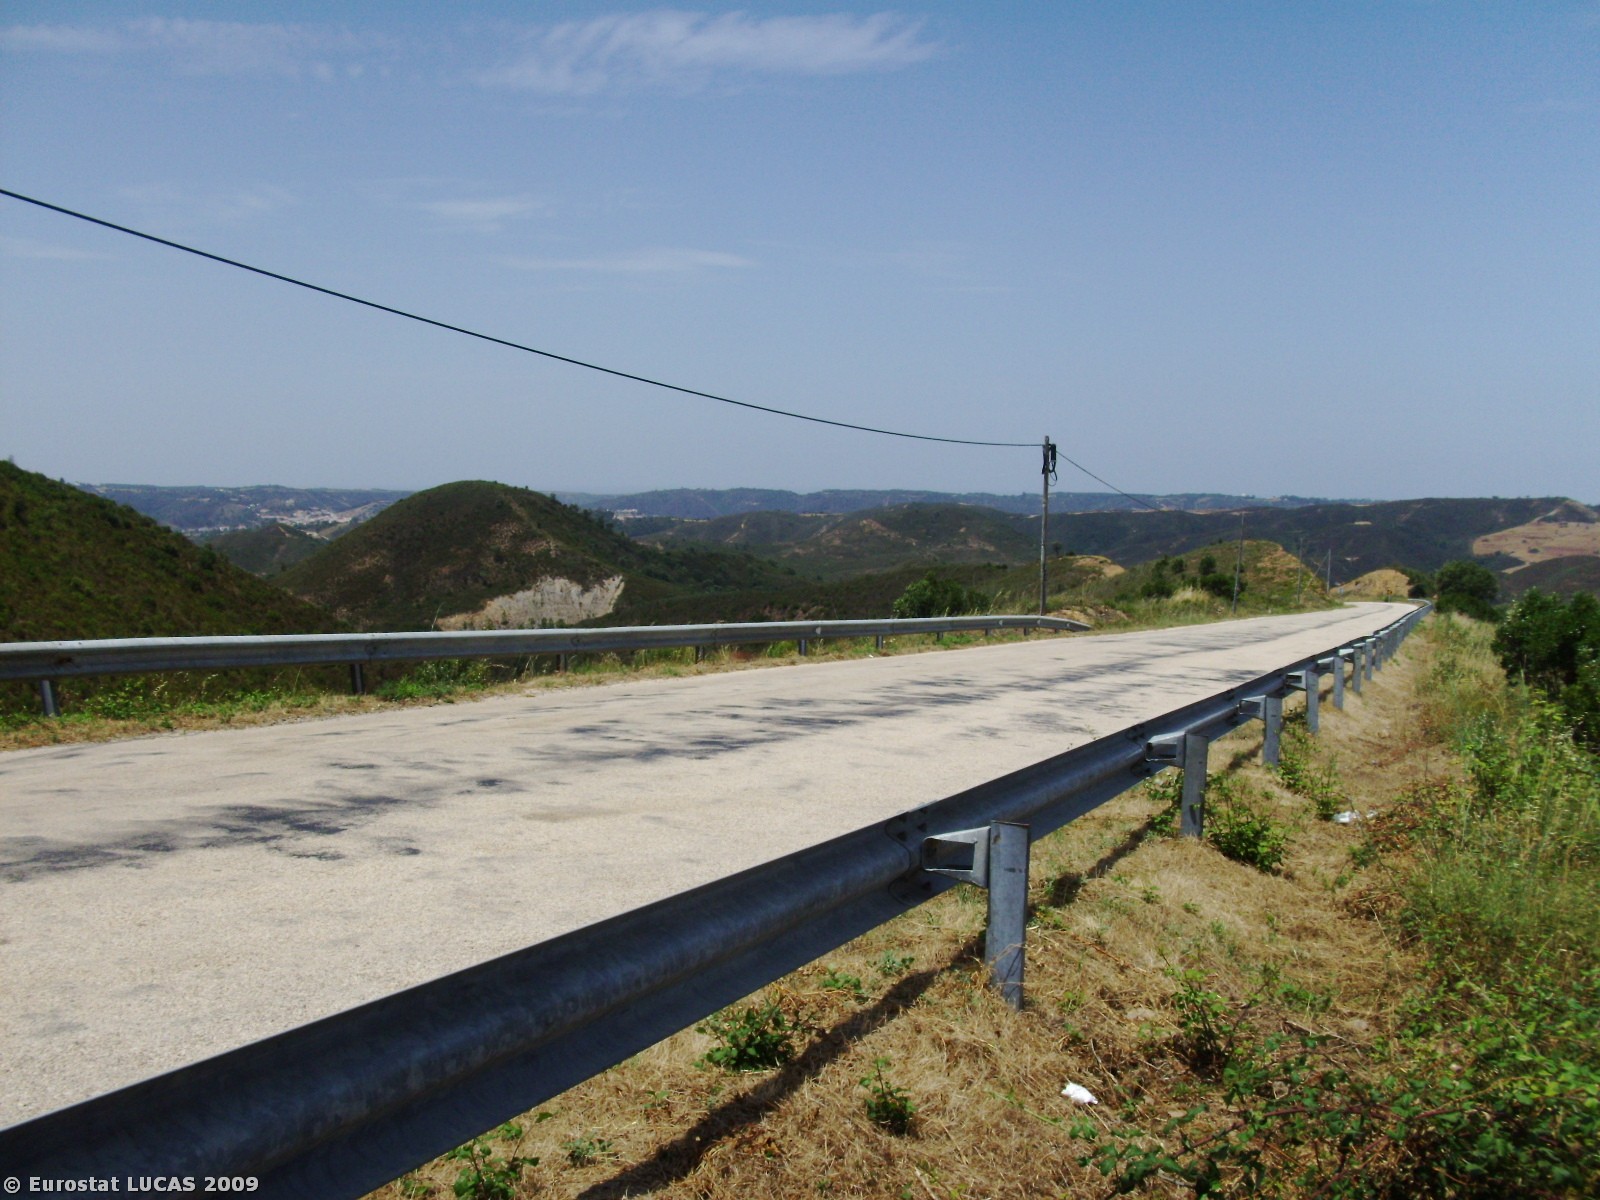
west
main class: Shrubland
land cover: Shrubland with sparse tree cover
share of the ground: > 75 %
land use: Nature reserves
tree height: < 5 m
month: June
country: PT
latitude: 37.3104
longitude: -8.7533
